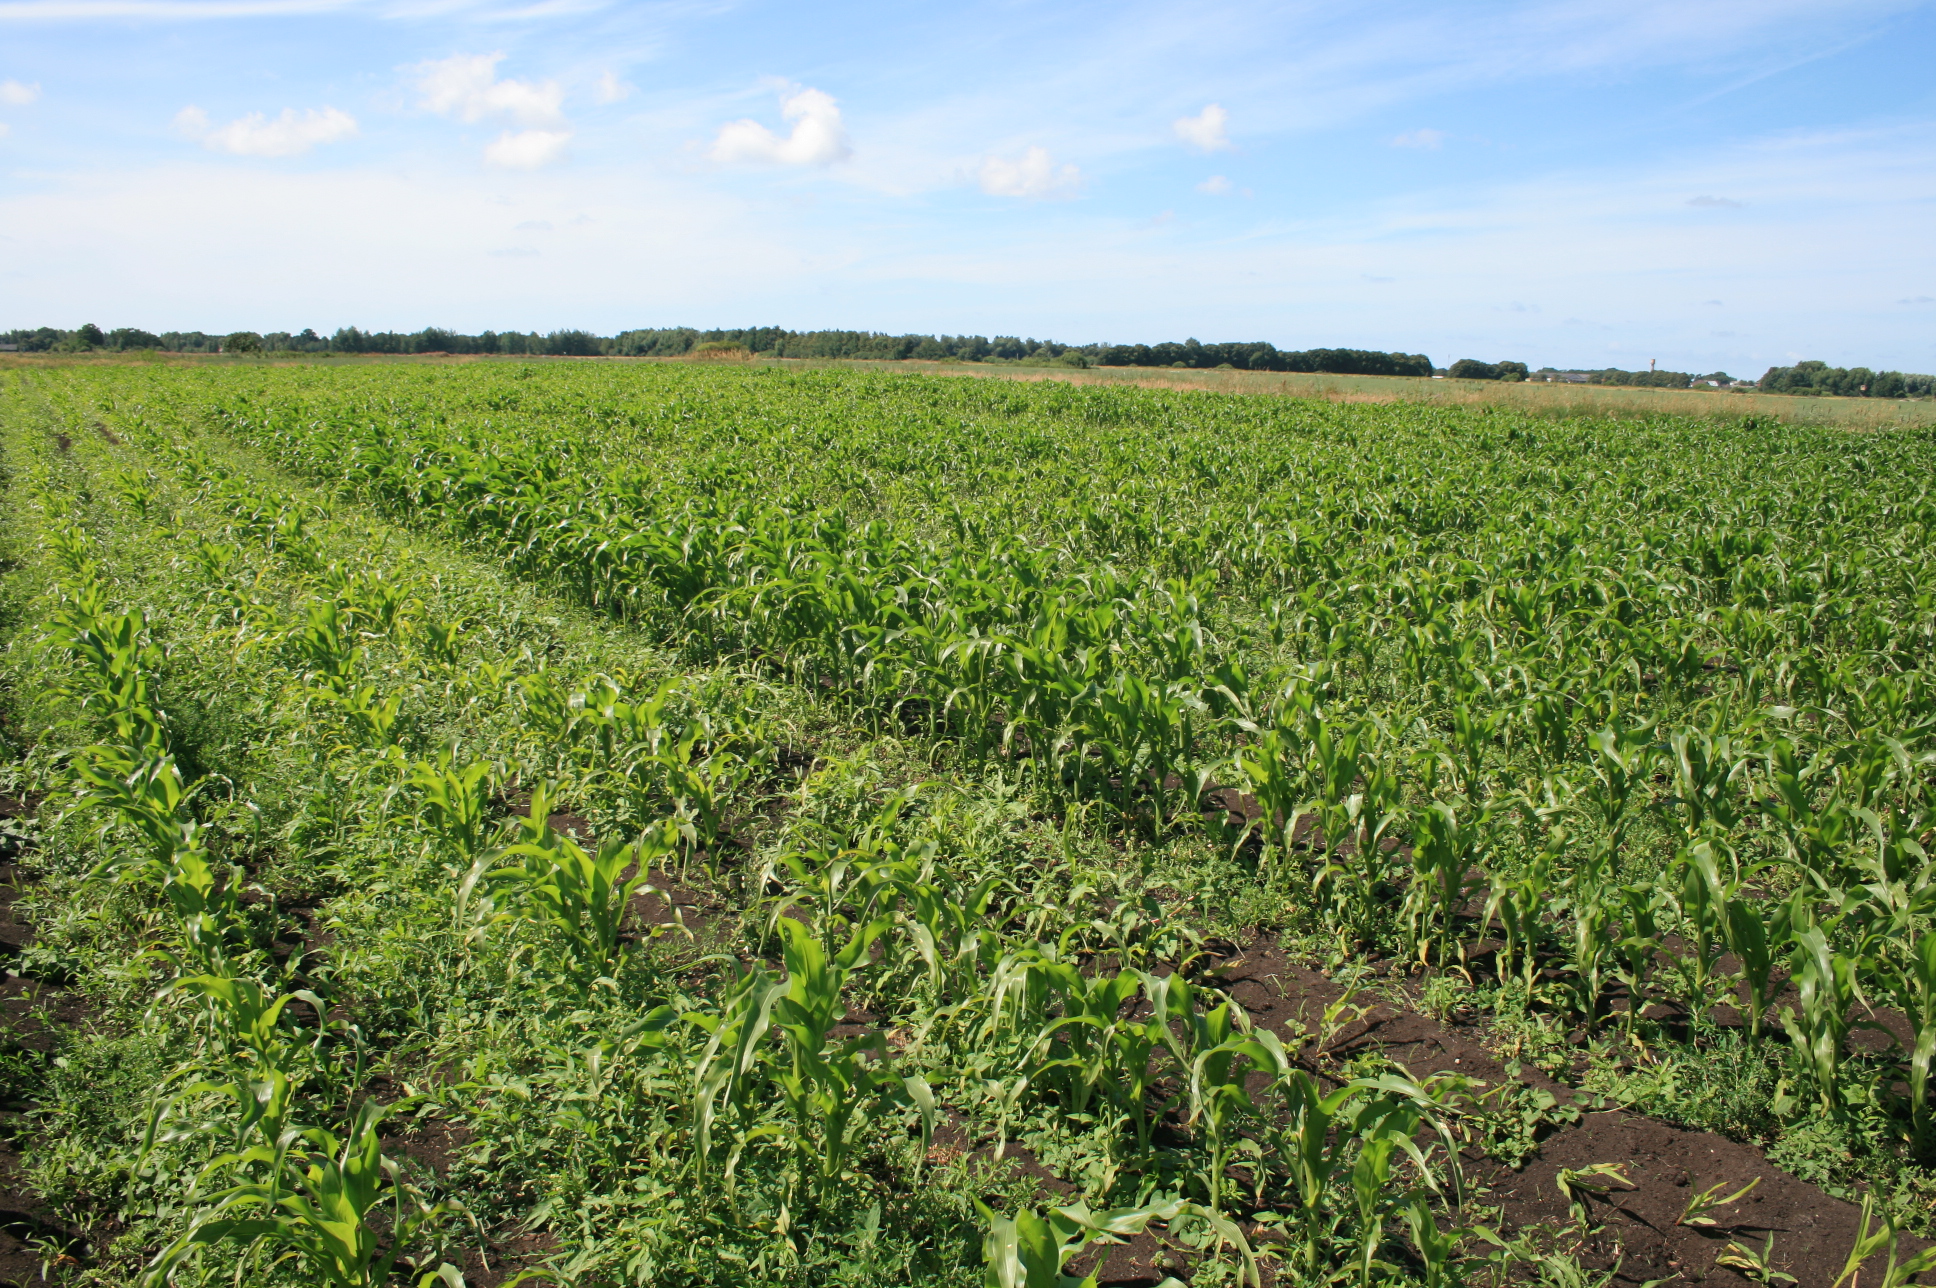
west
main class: Cropland
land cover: Maize
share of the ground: > 75 %
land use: Agriculture (excluding fallow land and kitchen gardens)
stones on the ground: < 10 %
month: July
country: LT
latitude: 55.5079
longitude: 21.2689
